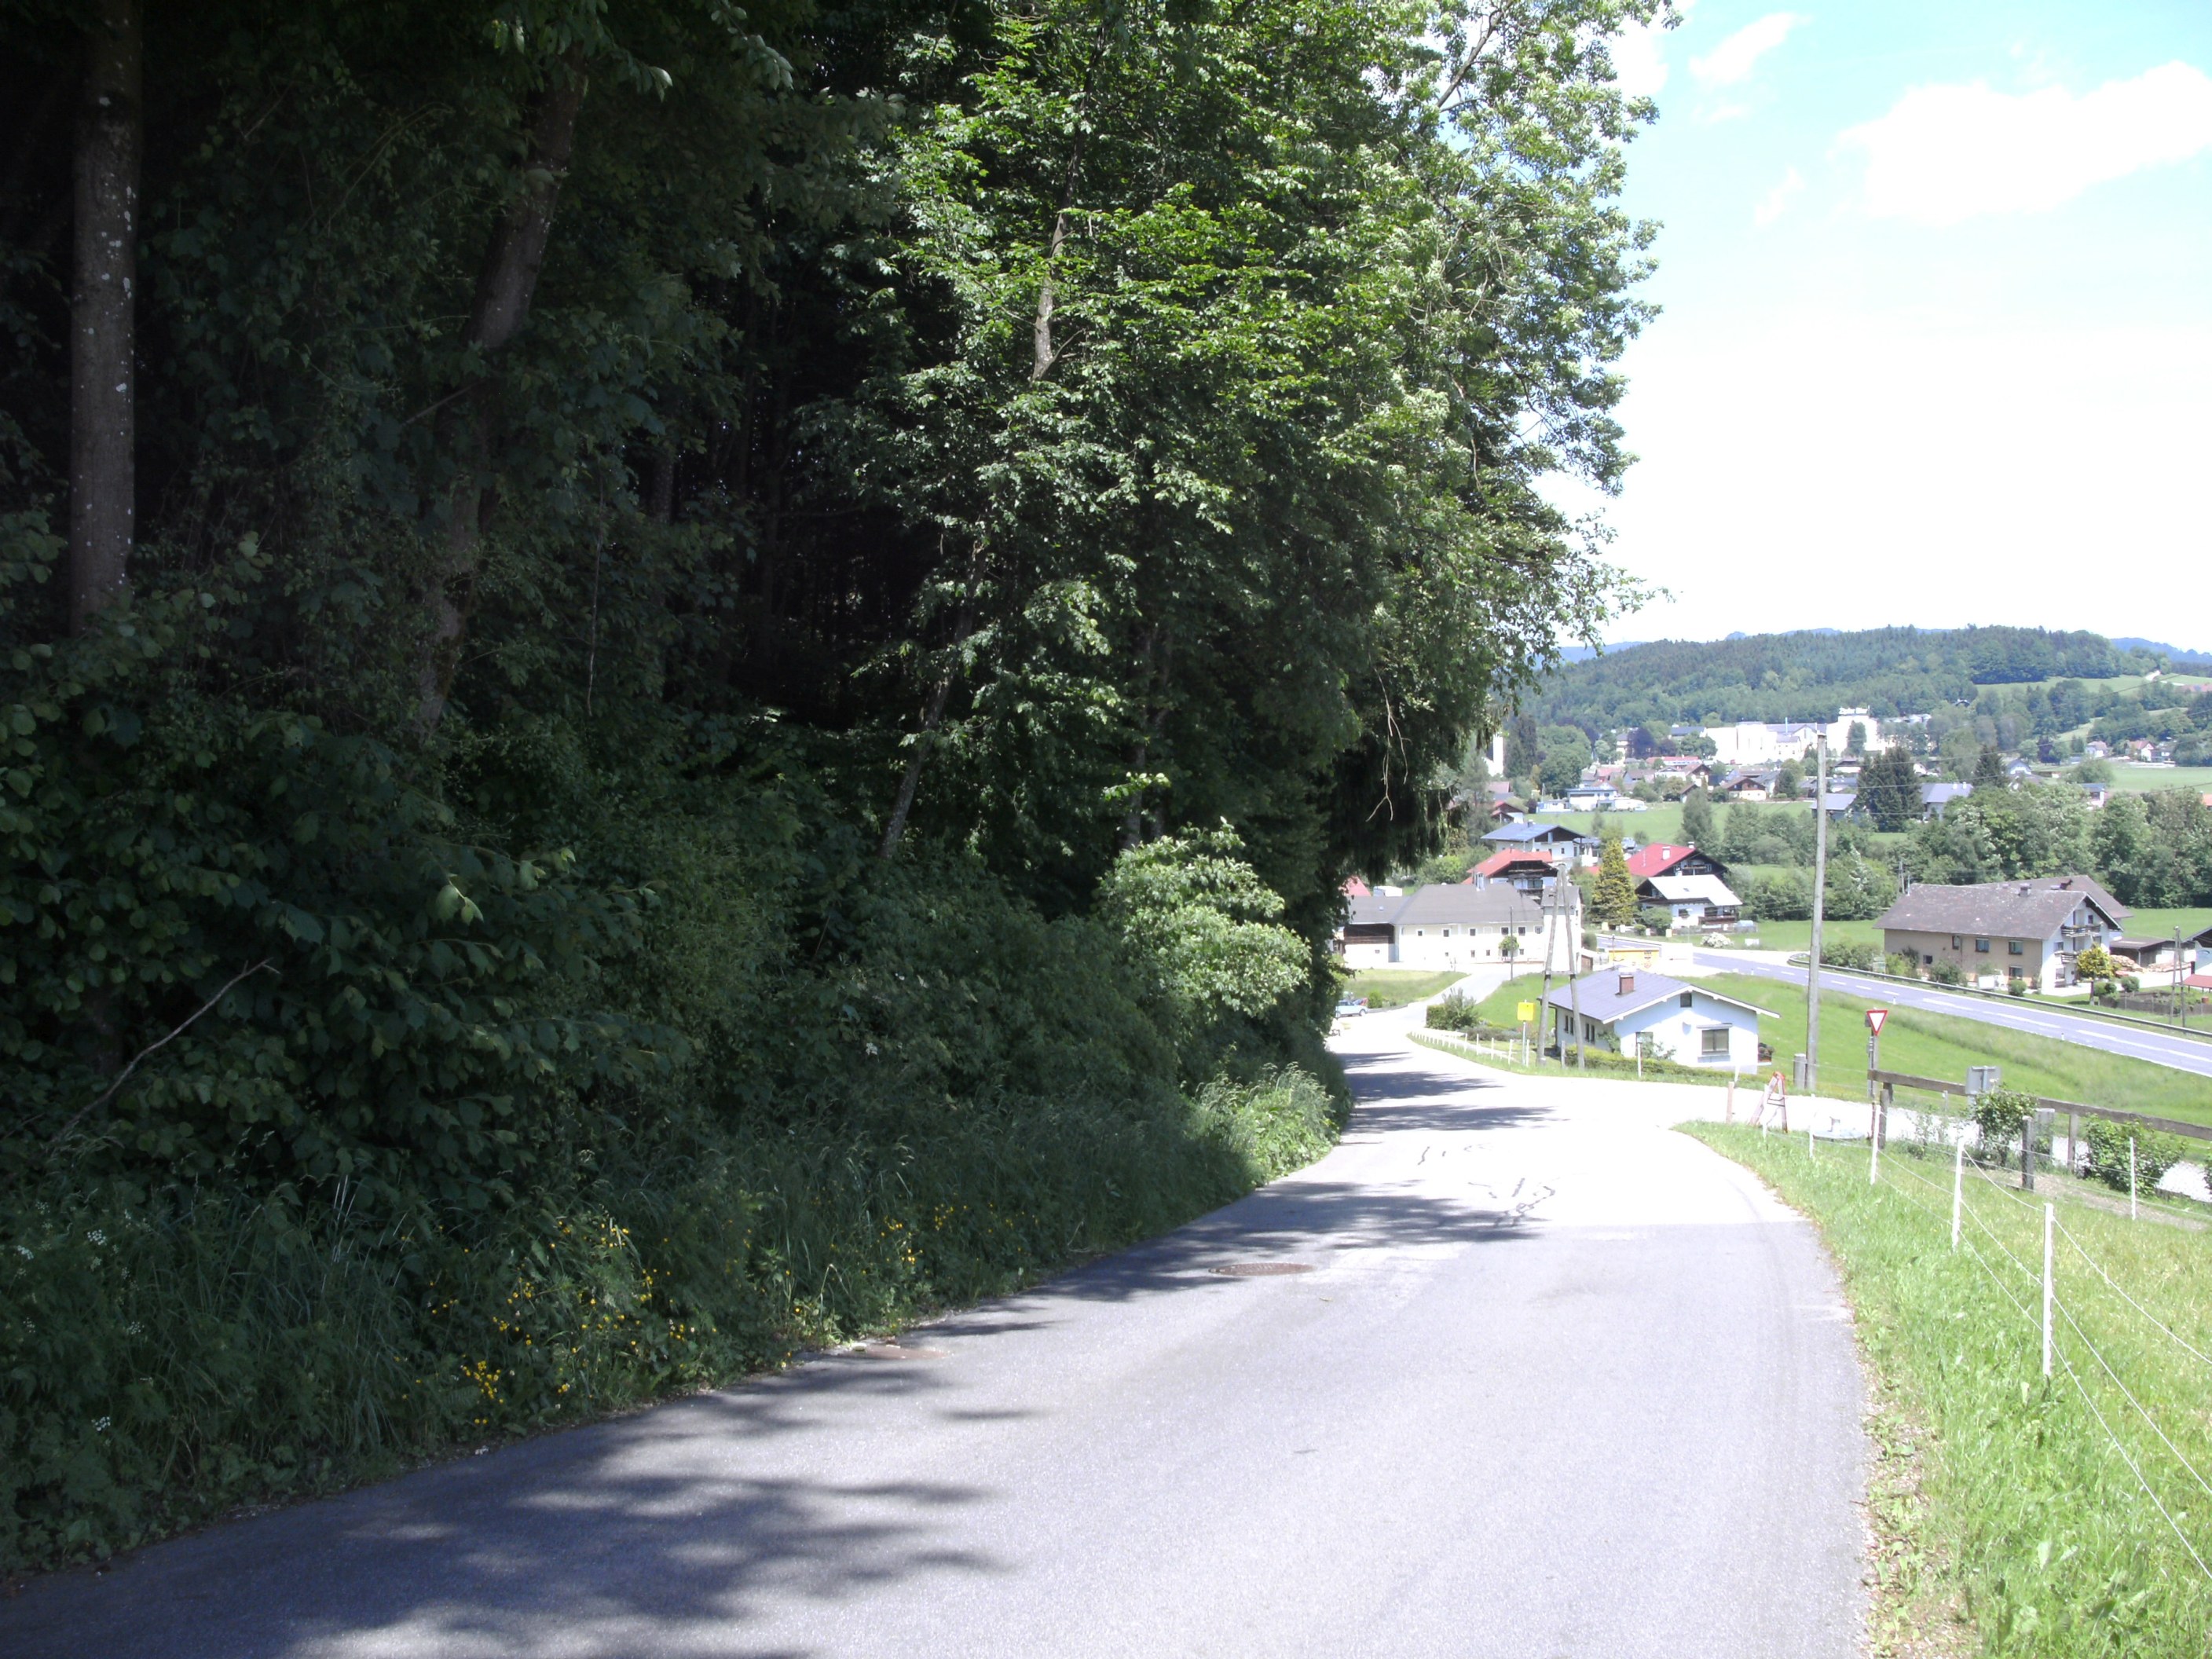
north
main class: Grassland
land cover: Grassland without tree/shrub cover
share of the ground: > 75 %
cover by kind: herbaceous plants 100 %
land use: Agriculture (excluding fallow land and kitchen gardens)
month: May
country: AT
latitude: 48.0240
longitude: 13.4987
